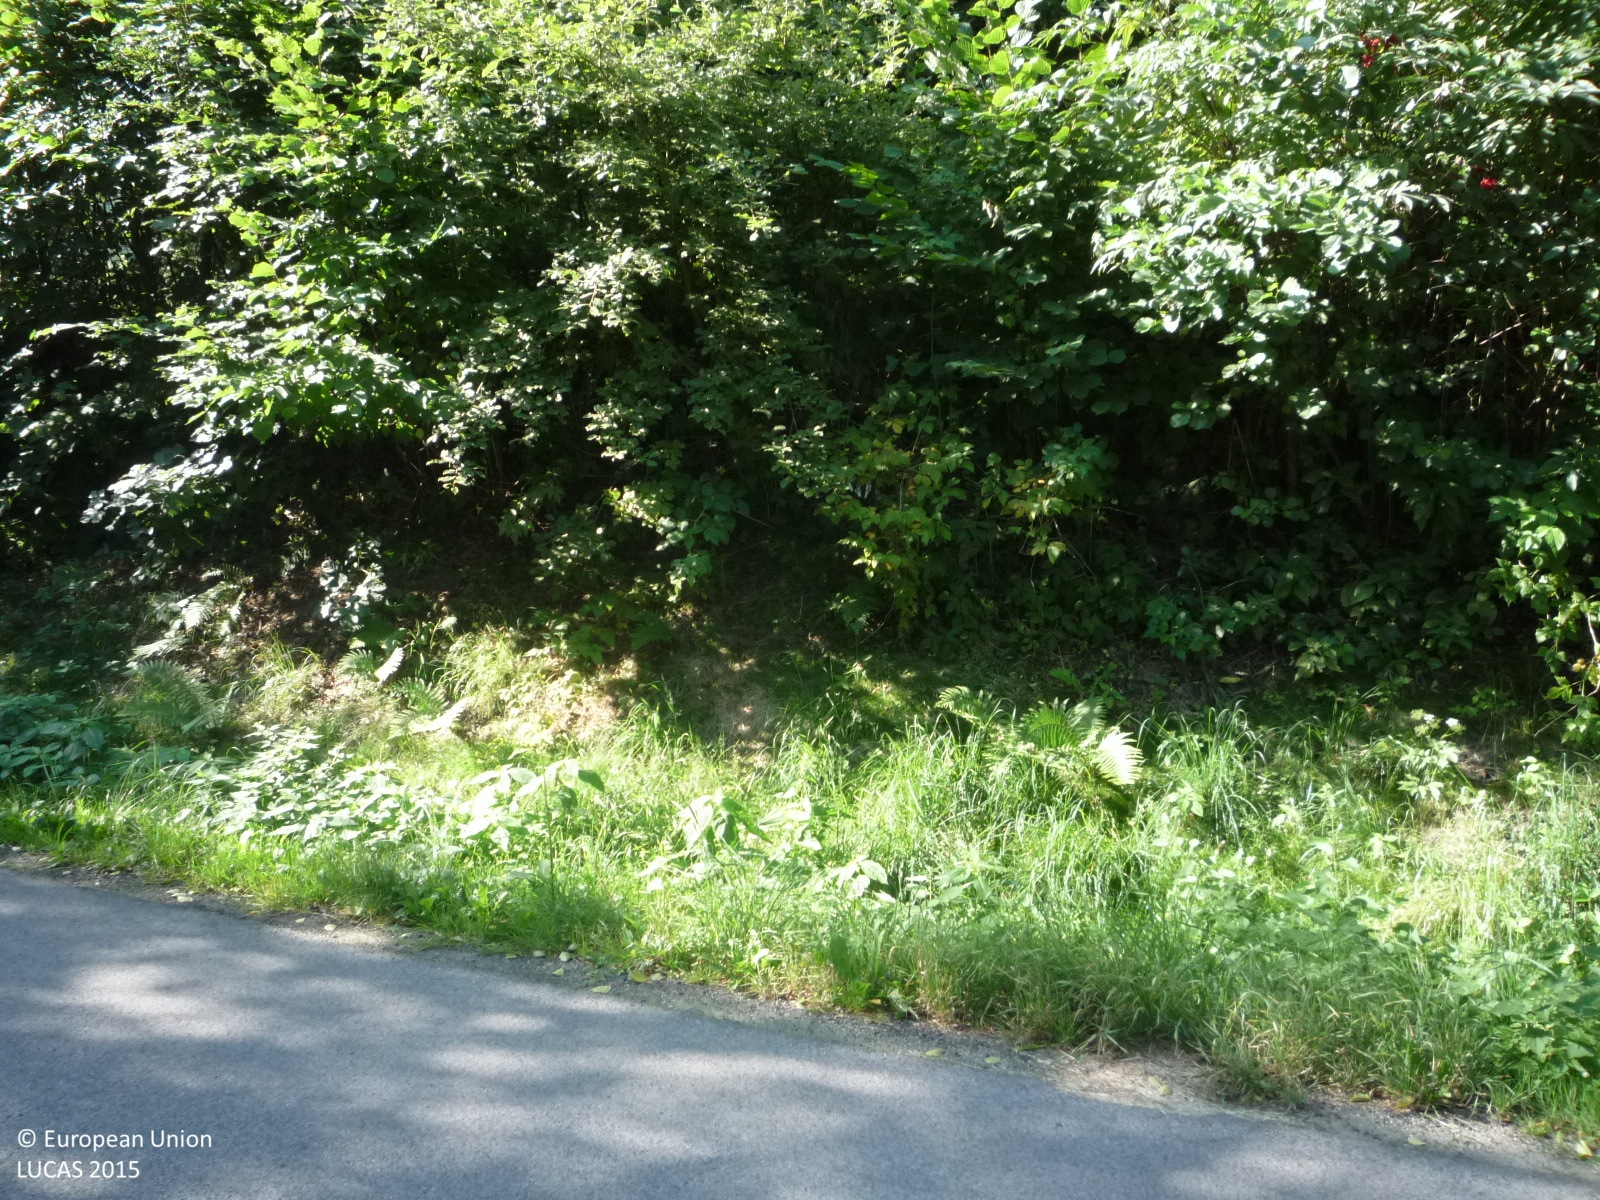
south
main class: Woodland
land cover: Broadleaved woodland
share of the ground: > 75 %
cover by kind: broadleaved forest trees 85 %, herbaceous plants 10 %, shrubs 5 %
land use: Semi-natural and natural areas not in use
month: August
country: CZ
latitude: 50.6221
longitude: 15.2475
